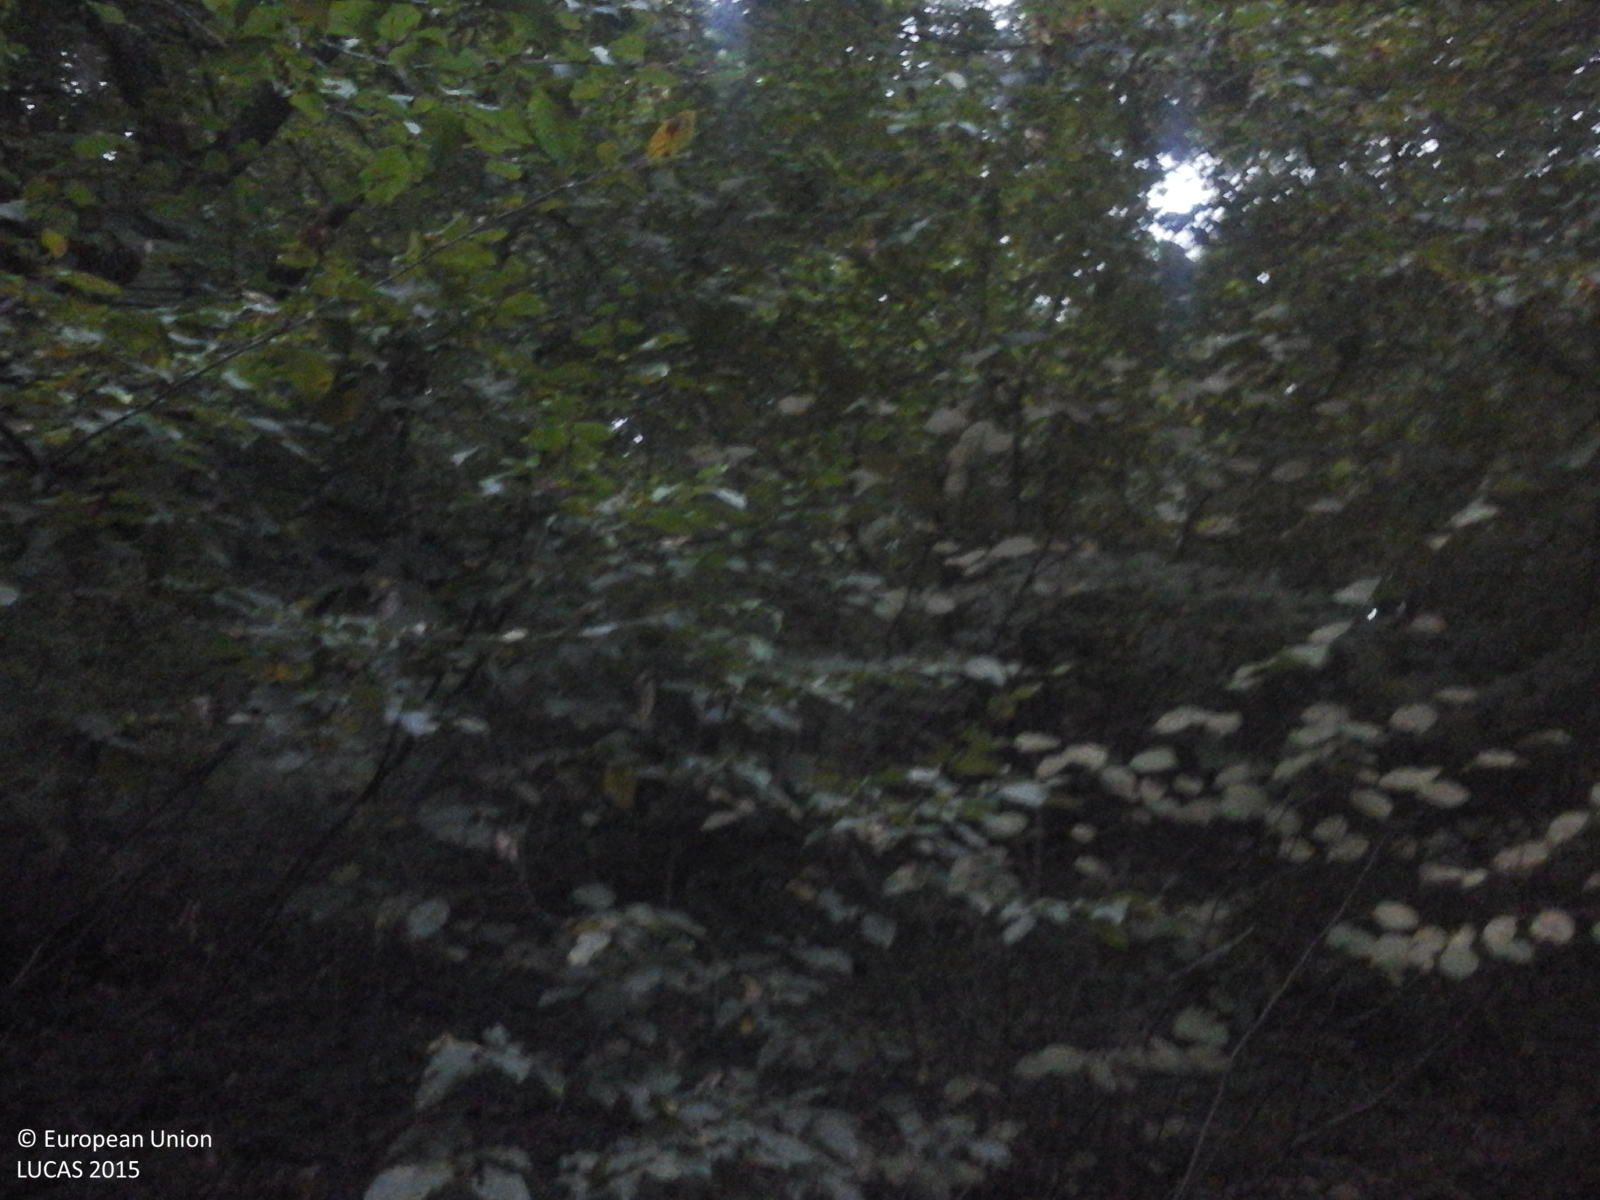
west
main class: Woodland
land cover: Broadleaved woodland
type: beech forest
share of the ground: > 75 %
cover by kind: broadleaved forest trees 100 %
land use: Forestry
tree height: > 5 m
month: October
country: RO
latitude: 46.2899
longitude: 25.2761
